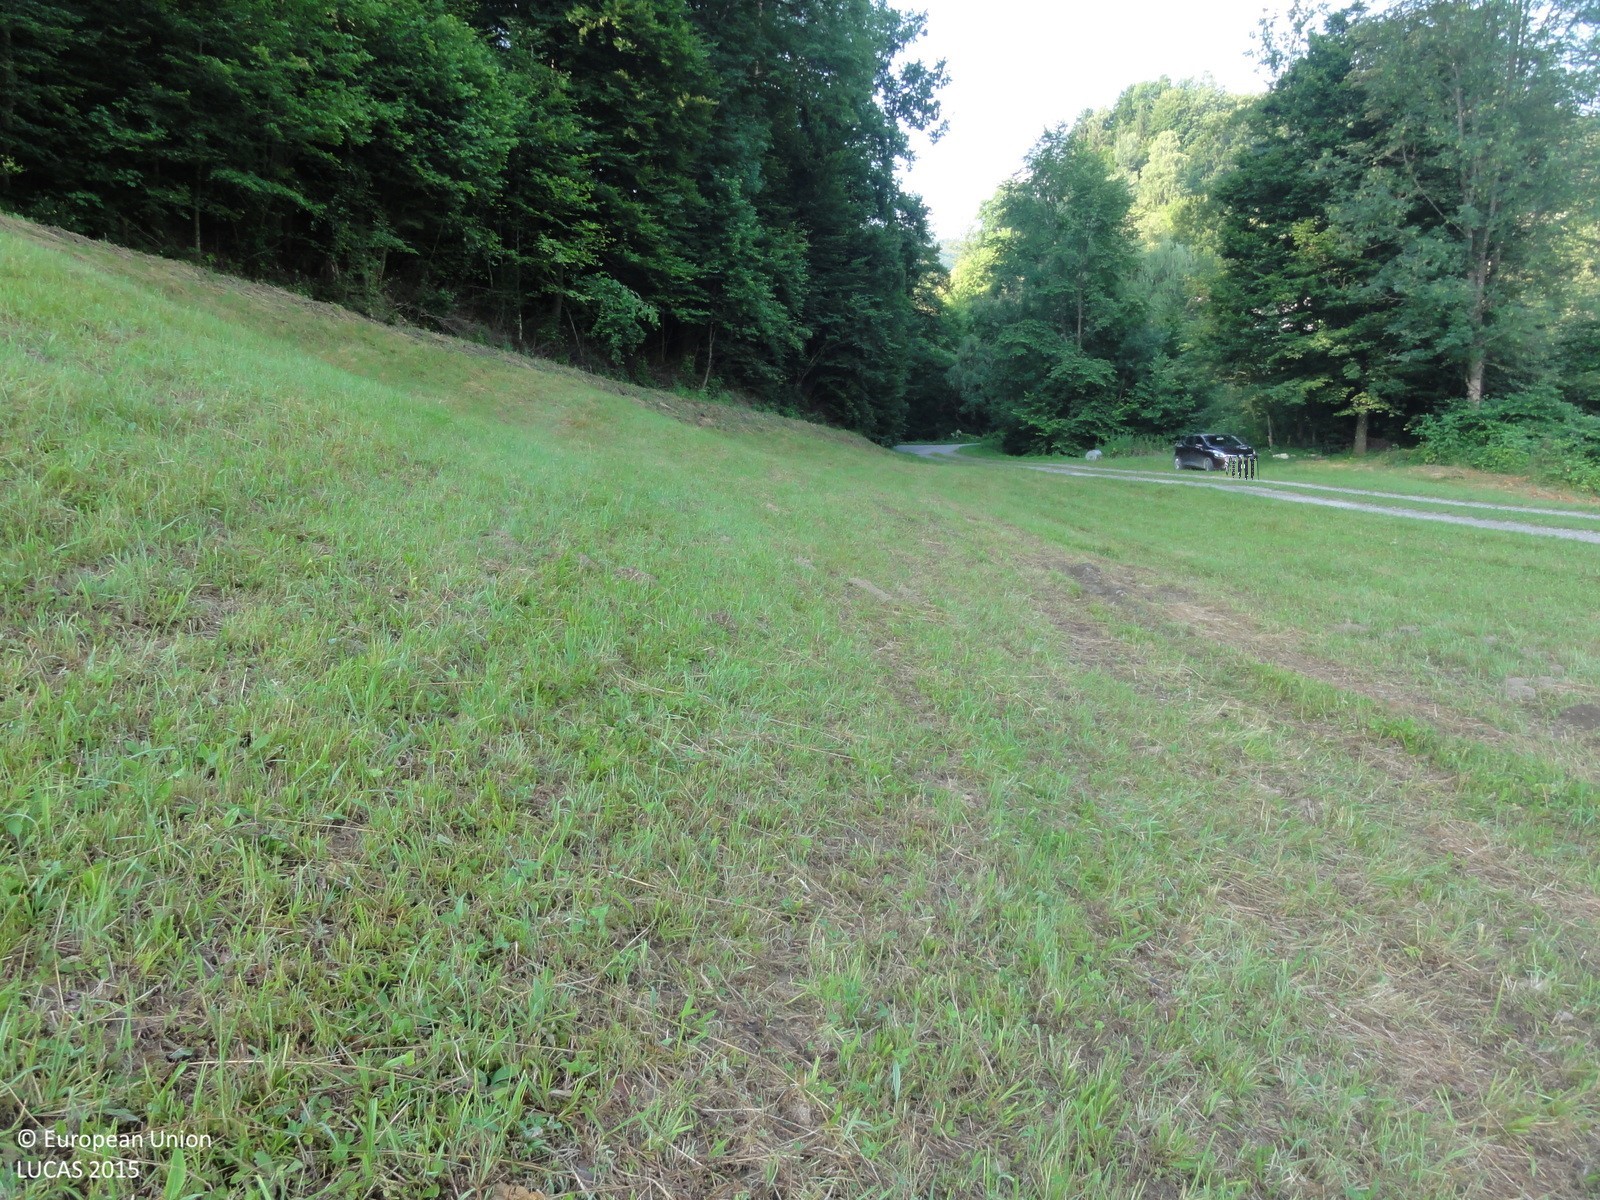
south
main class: Grassland
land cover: Grassland without tree/shrub cover
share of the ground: > 75 %
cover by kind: herbaceous plants 100 %
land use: Agriculture (excluding fallow land and kitchen gardens)
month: July
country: SI
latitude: 46.6389
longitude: 15.5773
